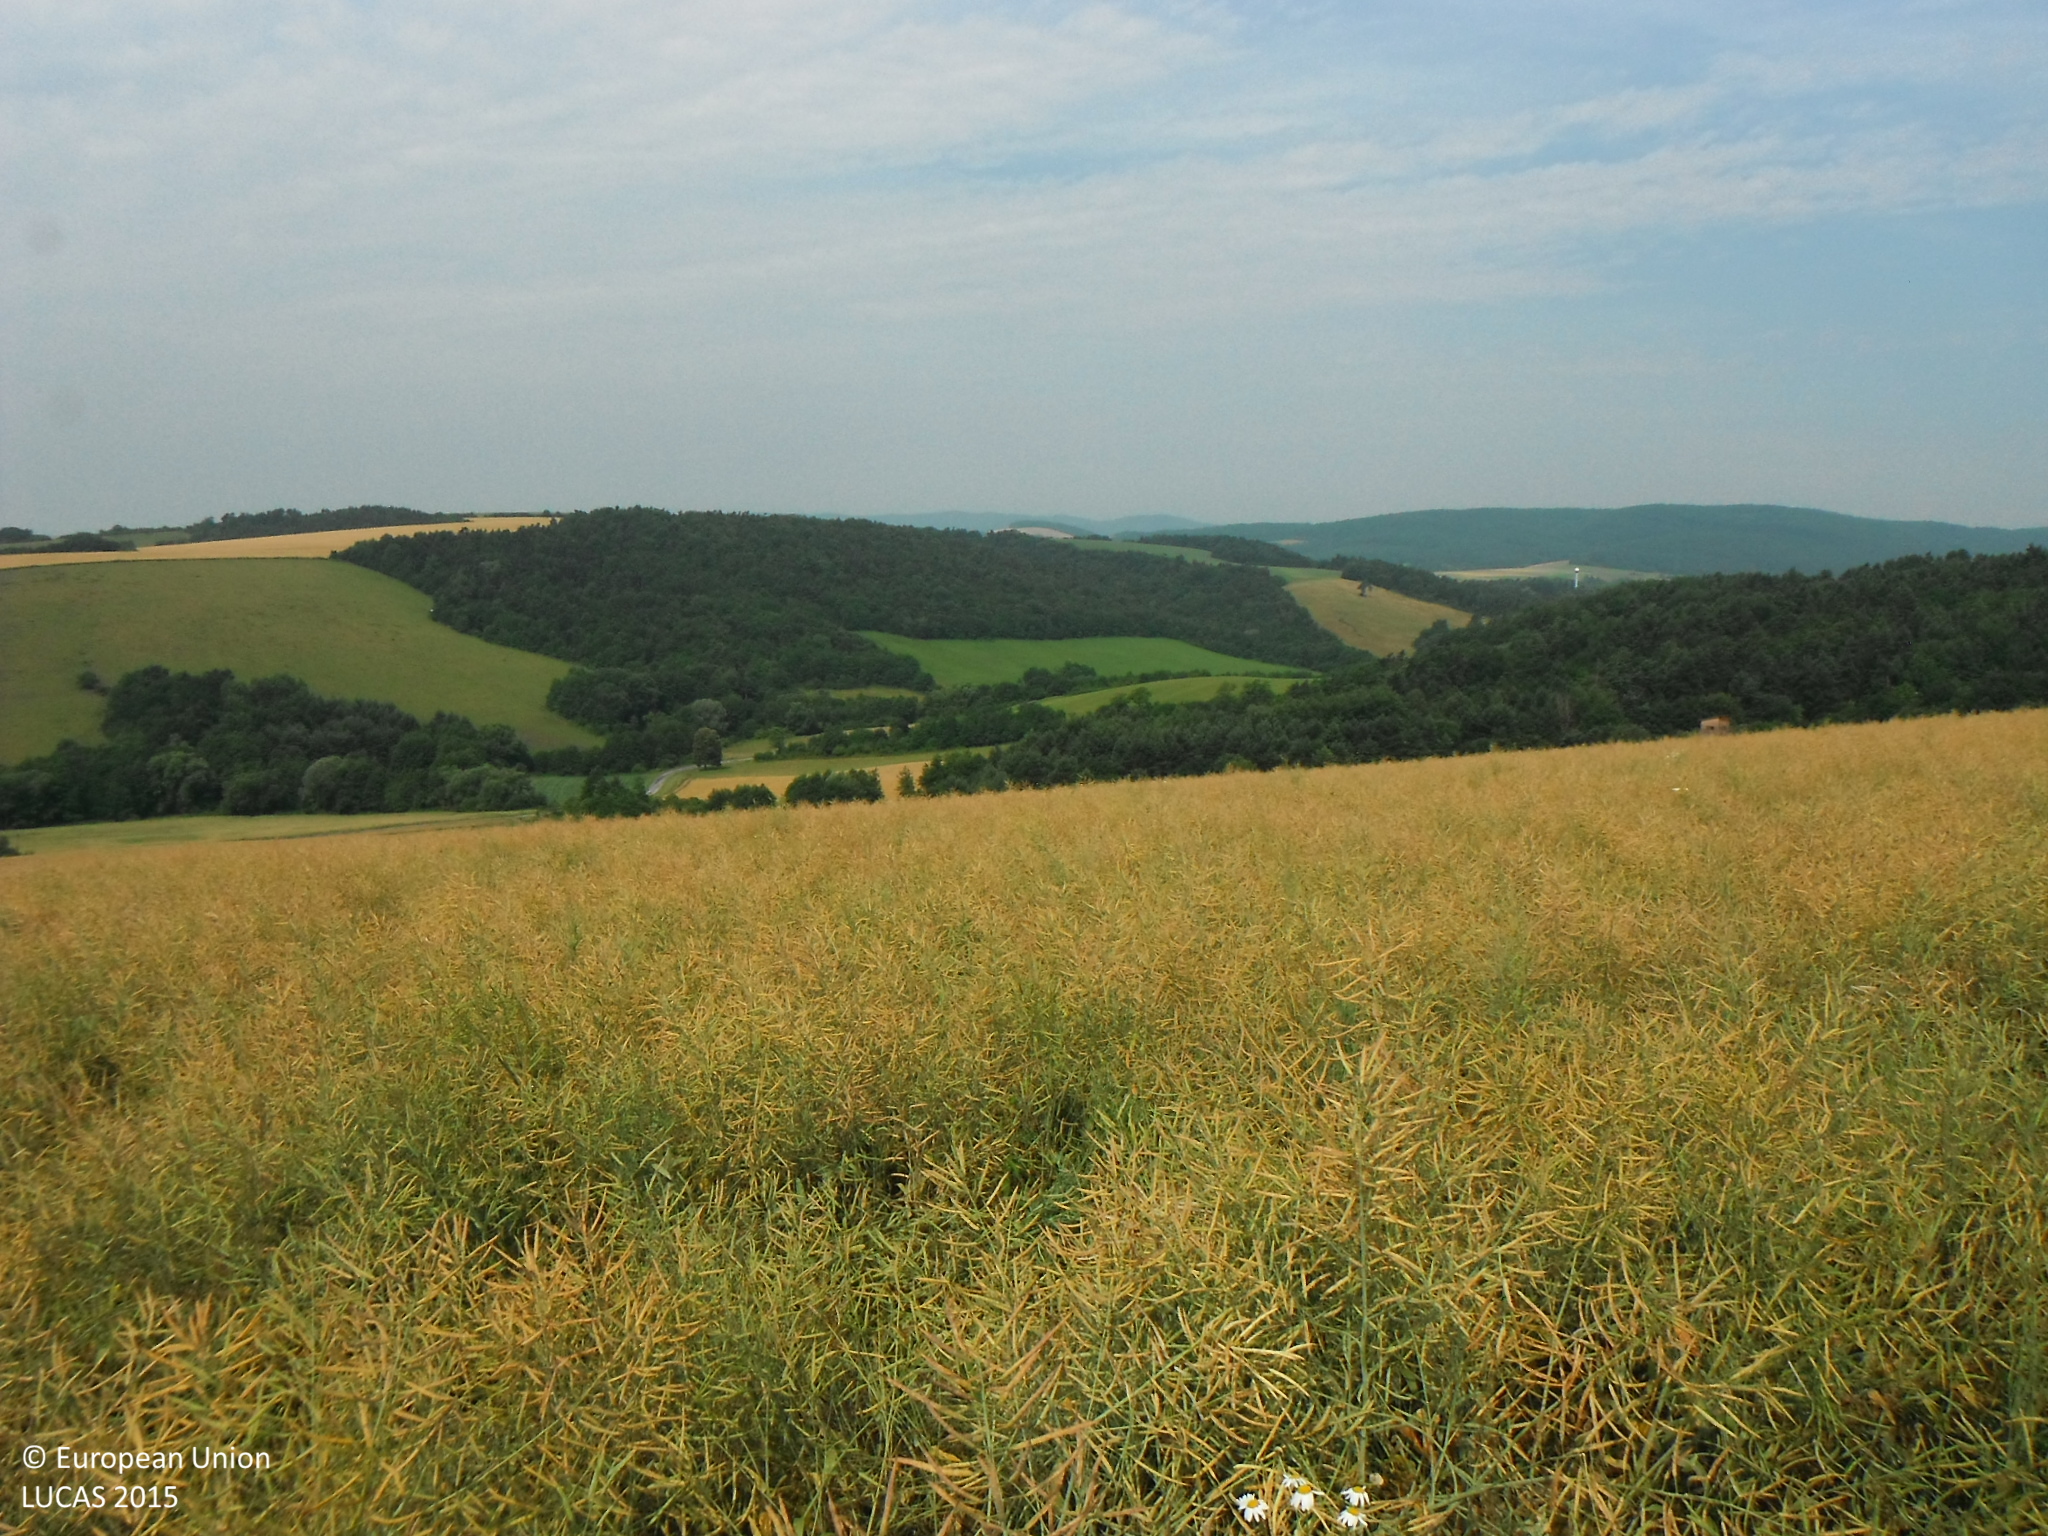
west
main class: Cropland
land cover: Rape and turnip rape
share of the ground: > 75 %
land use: Agriculture (excluding fallow land and kitchen gardens)
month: July
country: SK
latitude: 49.1725
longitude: 21.4186
